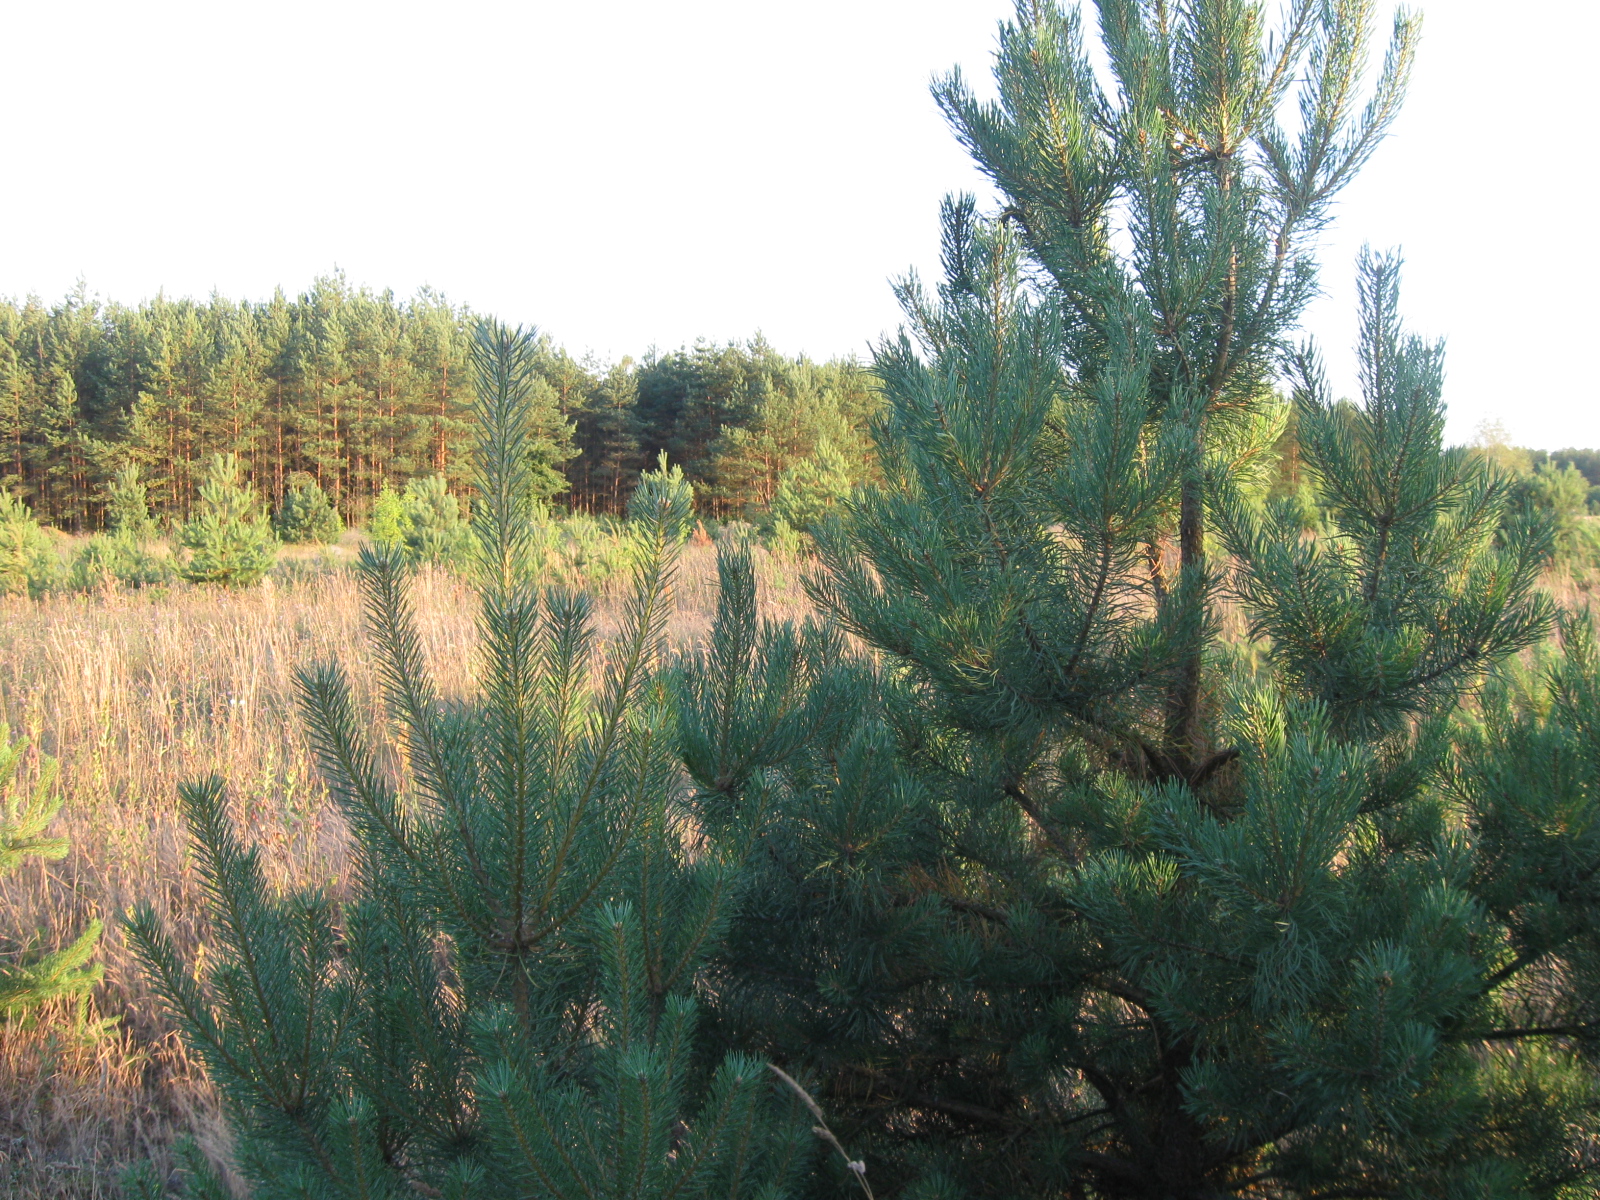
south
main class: Woodland
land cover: Pine dominated coniferous woodland
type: hemiboreal forest and nemoral coniferous forest and mixed broadleaved-coniferous forest
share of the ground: 25 - 50 %
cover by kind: herbaceous plants 55 %, coniferous forest trees 45 %
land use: Forestry
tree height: < 5 m
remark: Nursery
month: July
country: LT
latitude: 54.0956
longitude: 23.7110
